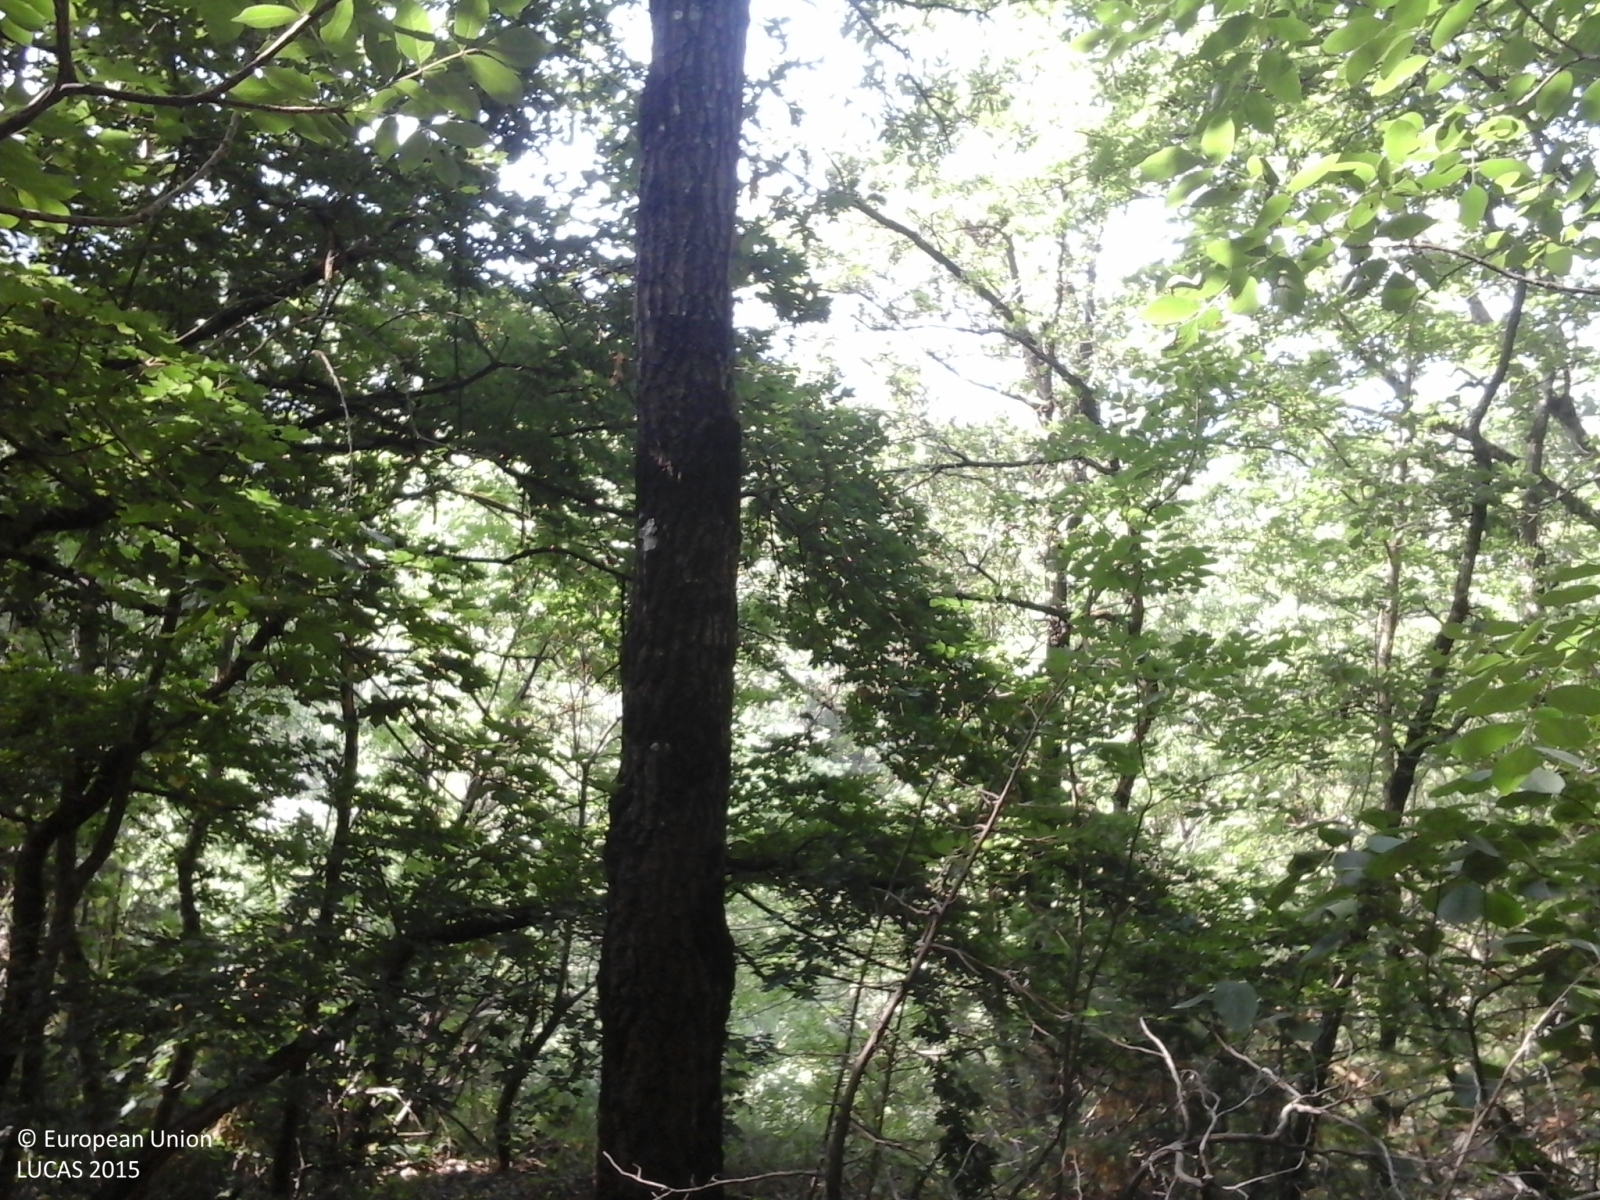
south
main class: Woodland
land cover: Broadleaved woodland
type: thermophilous deciduous forest
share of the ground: > 75 %
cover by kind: broadleaved forest trees 100 %
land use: Forestry
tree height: > 5 m
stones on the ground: < 10 %
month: July
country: IT
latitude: 44.4405
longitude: 10.2382
